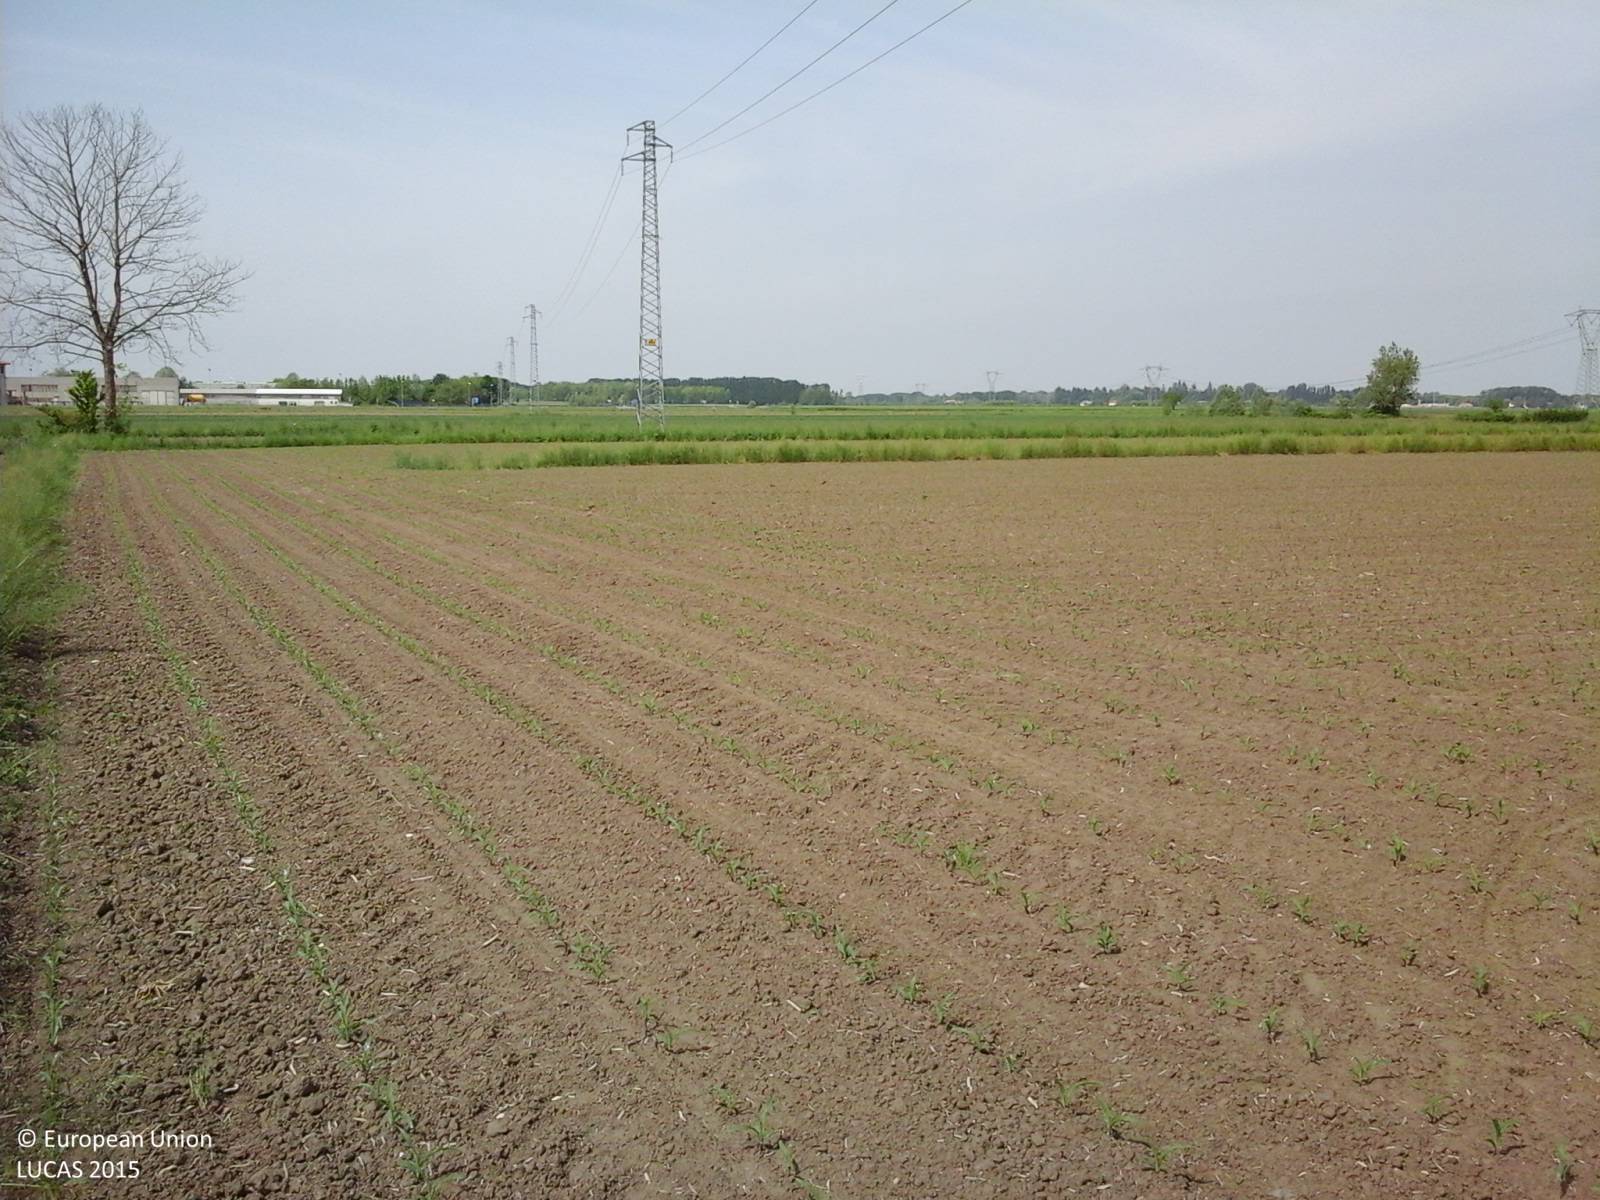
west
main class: Cropland
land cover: Maize
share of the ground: < 10 %
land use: Agriculture (excluding fallow land and kitchen gardens)
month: May
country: IT
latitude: 45.8218
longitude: 13.0209
